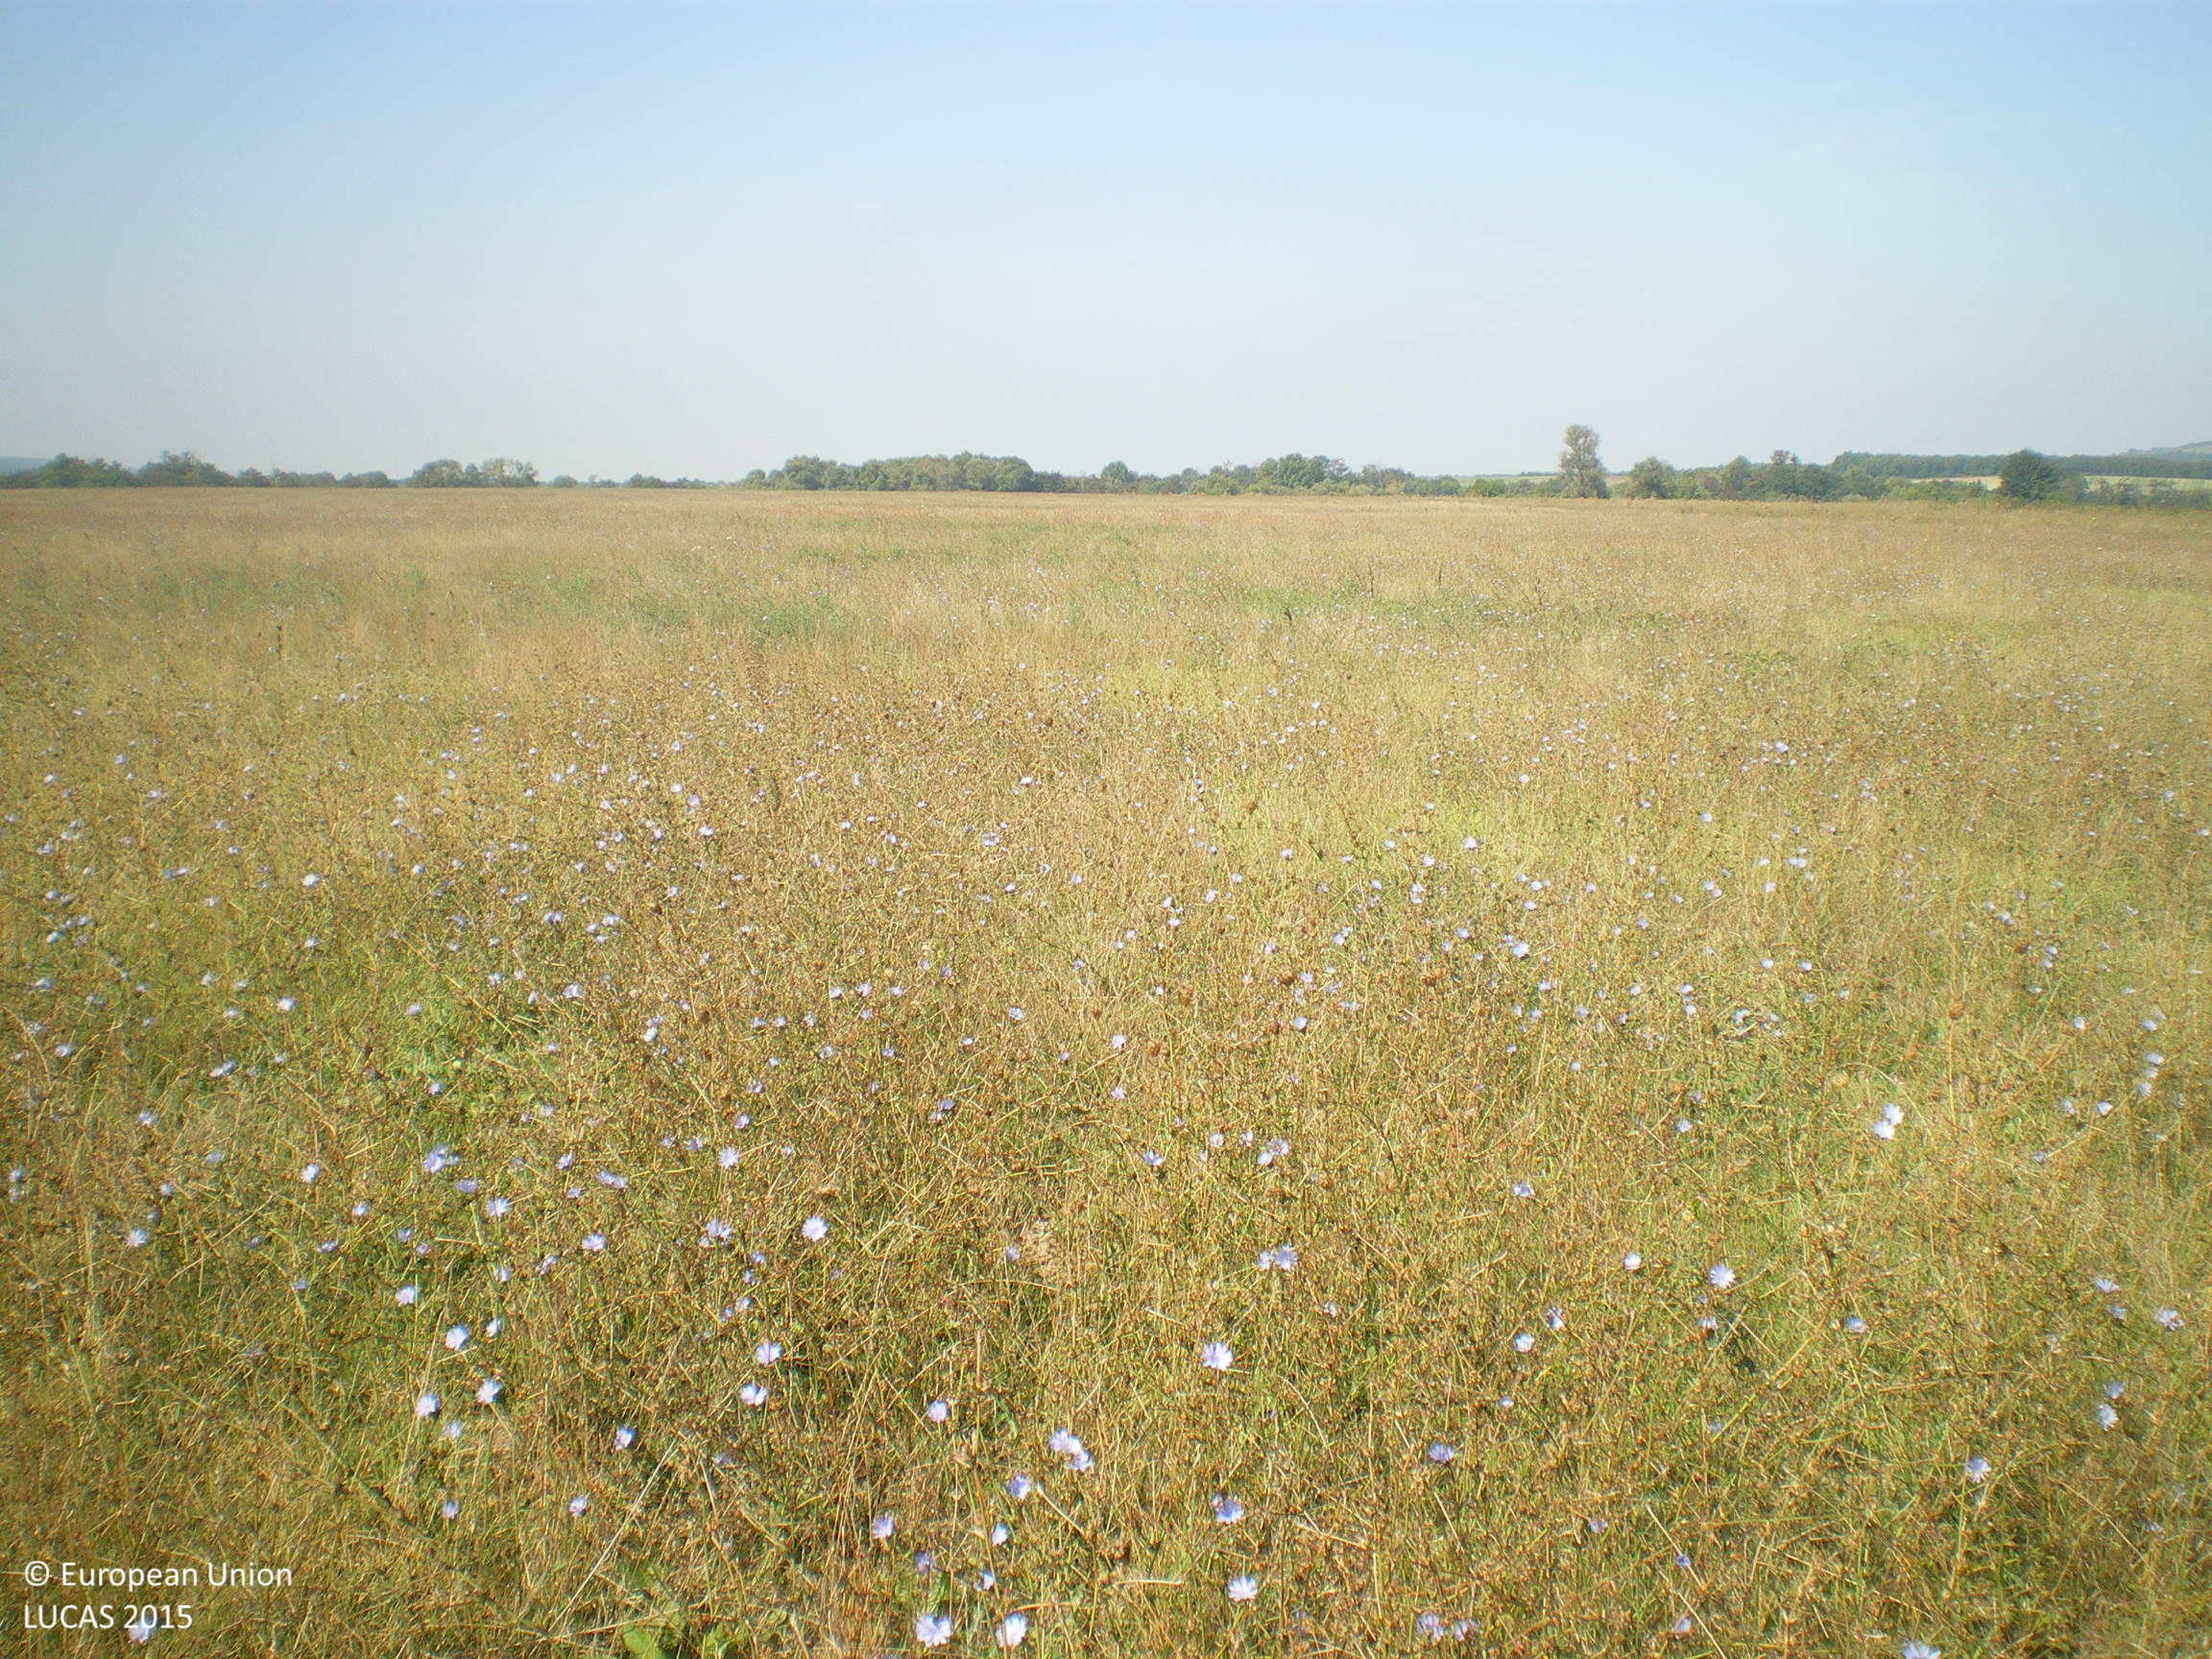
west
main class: Grassland
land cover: Grassland without tree/shrub cover
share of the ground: > 75 %
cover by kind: herbaceous plants 100 %
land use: Agriculture (excluding fallow land and kitchen gardens)
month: September
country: BG
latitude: 41.7786
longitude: 25.9885
